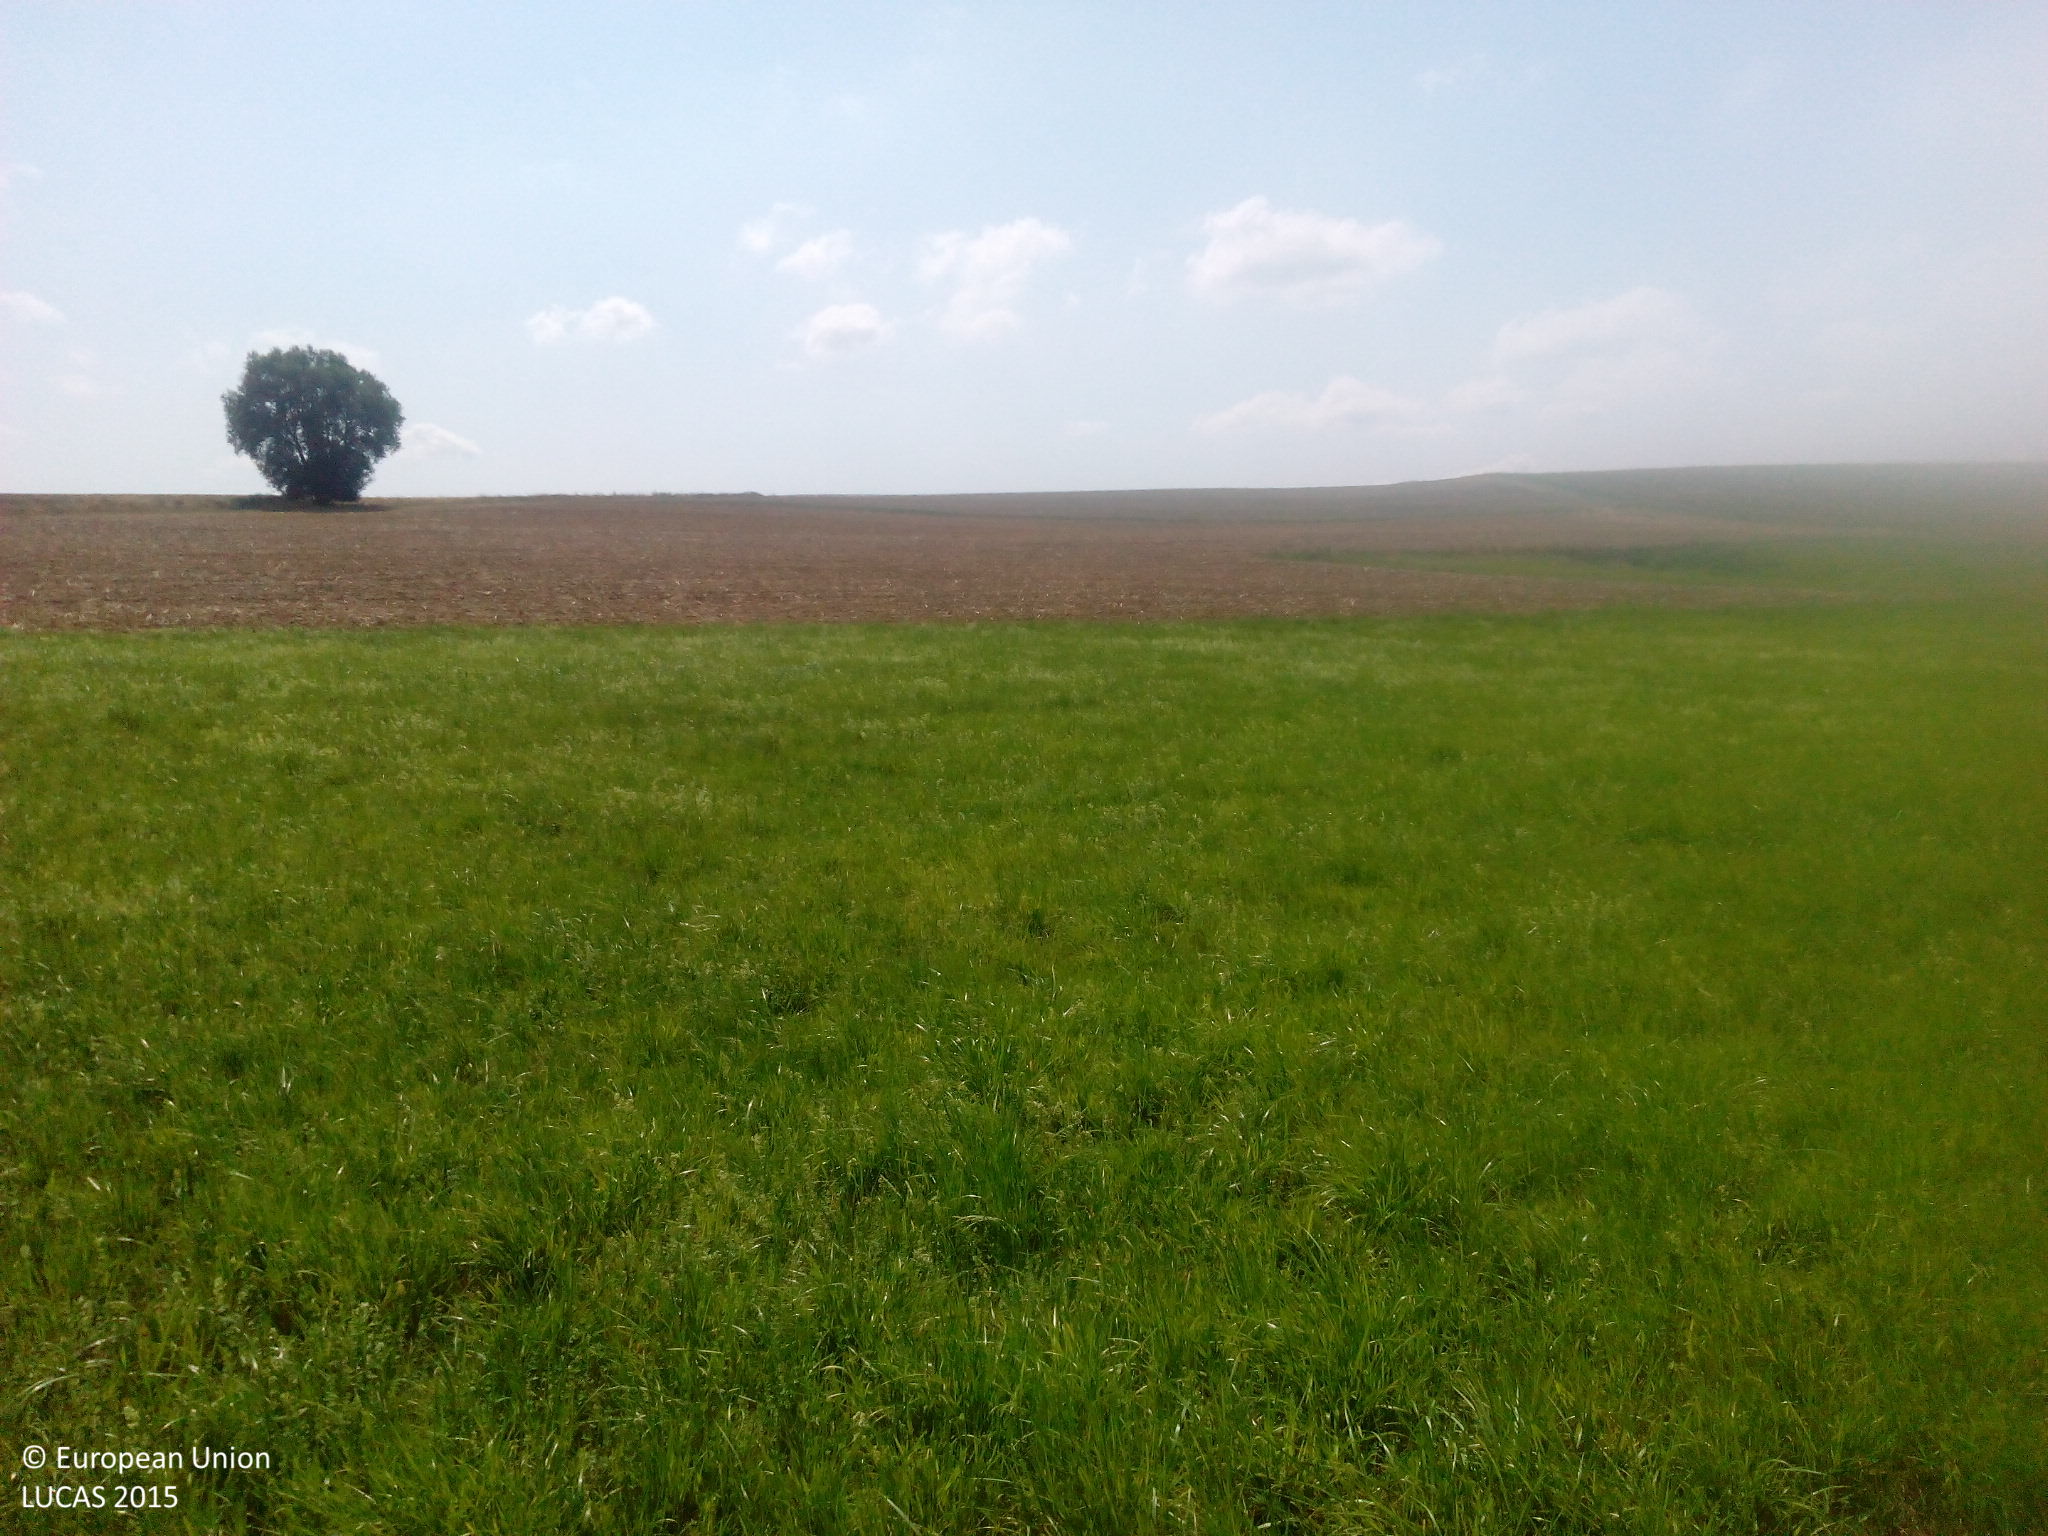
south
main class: Grassland
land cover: Grassland without tree/shrub cover
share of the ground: > 75 %
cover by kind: herbaceous plants 95 %, unconsolidated bare surface 5 %
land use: Agriculture (excluding fallow land and kitchen gardens)
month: August
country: DE
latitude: 50.3304
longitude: 8.1039
